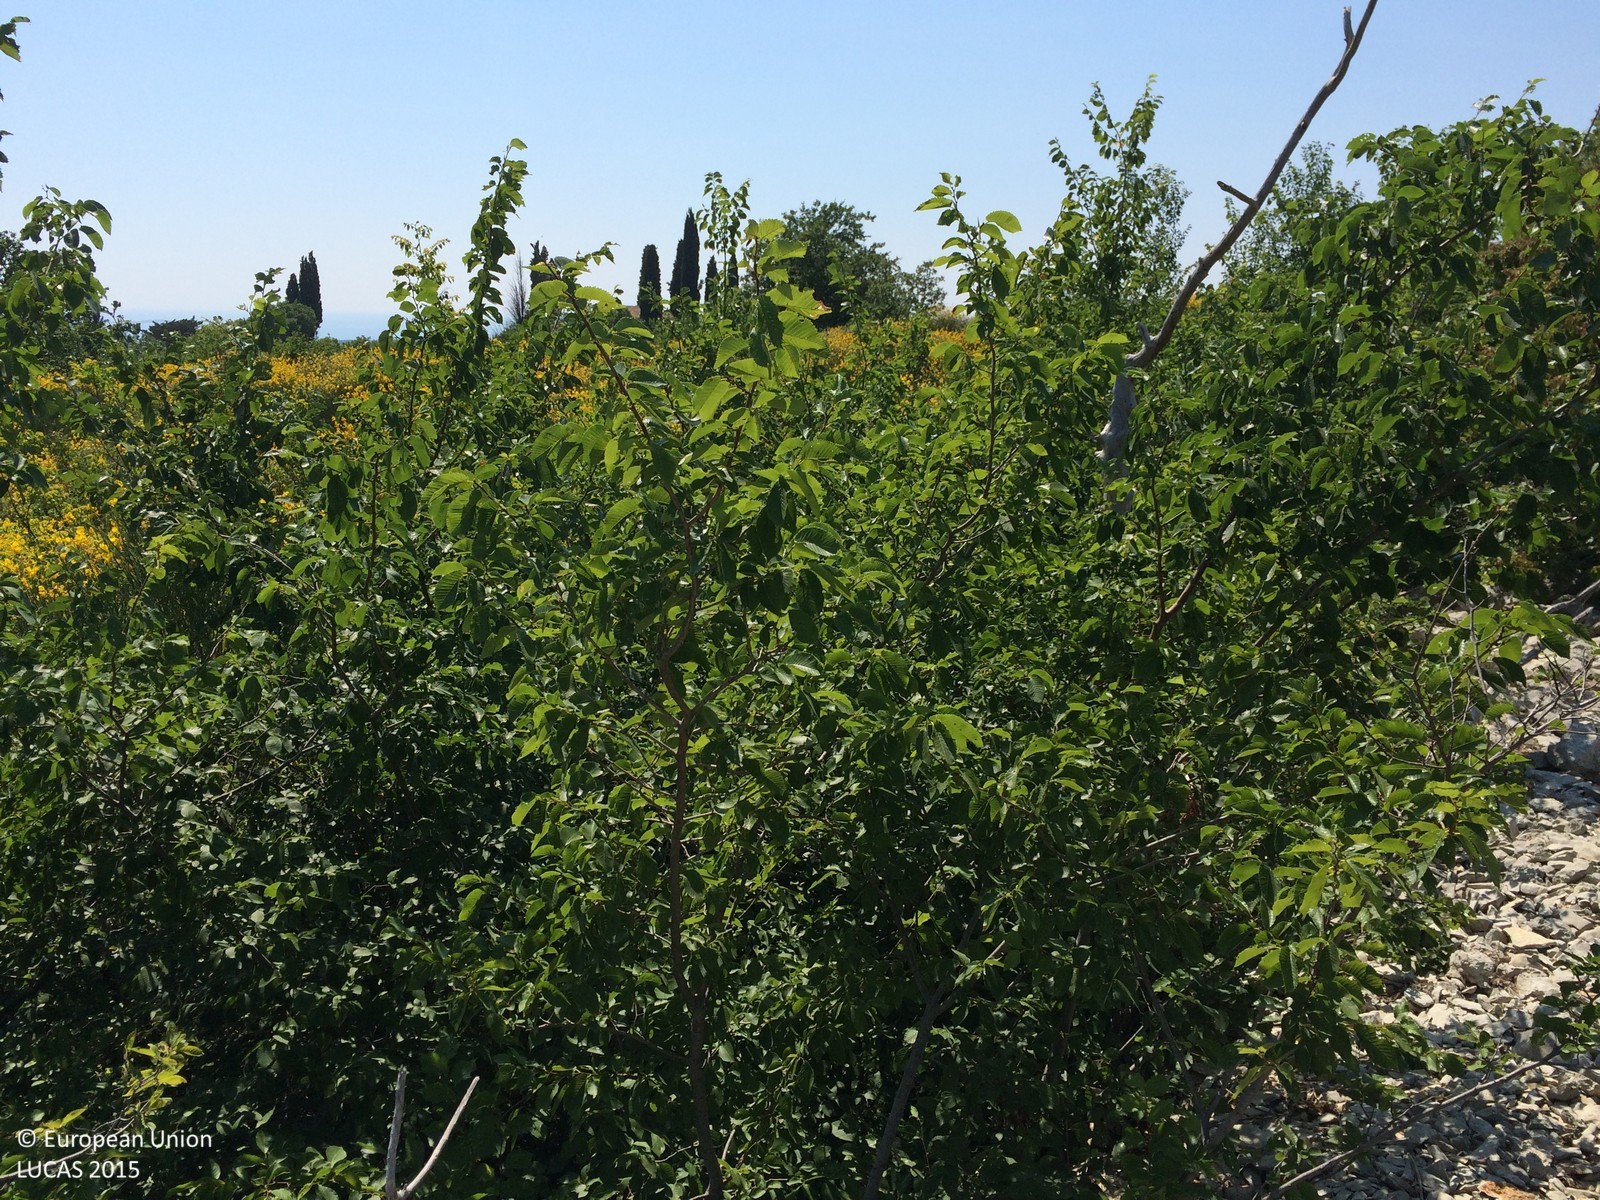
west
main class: Shrubland
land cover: Shrubland with sparse tree cover
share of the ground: > 75 %
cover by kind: shrubs 90 %, broadleaved forest trees 5 %, herbaceous plants 5 %
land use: Semi-natural and natural areas not in use
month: June
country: HR
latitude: 44.9836
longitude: 13.8370
